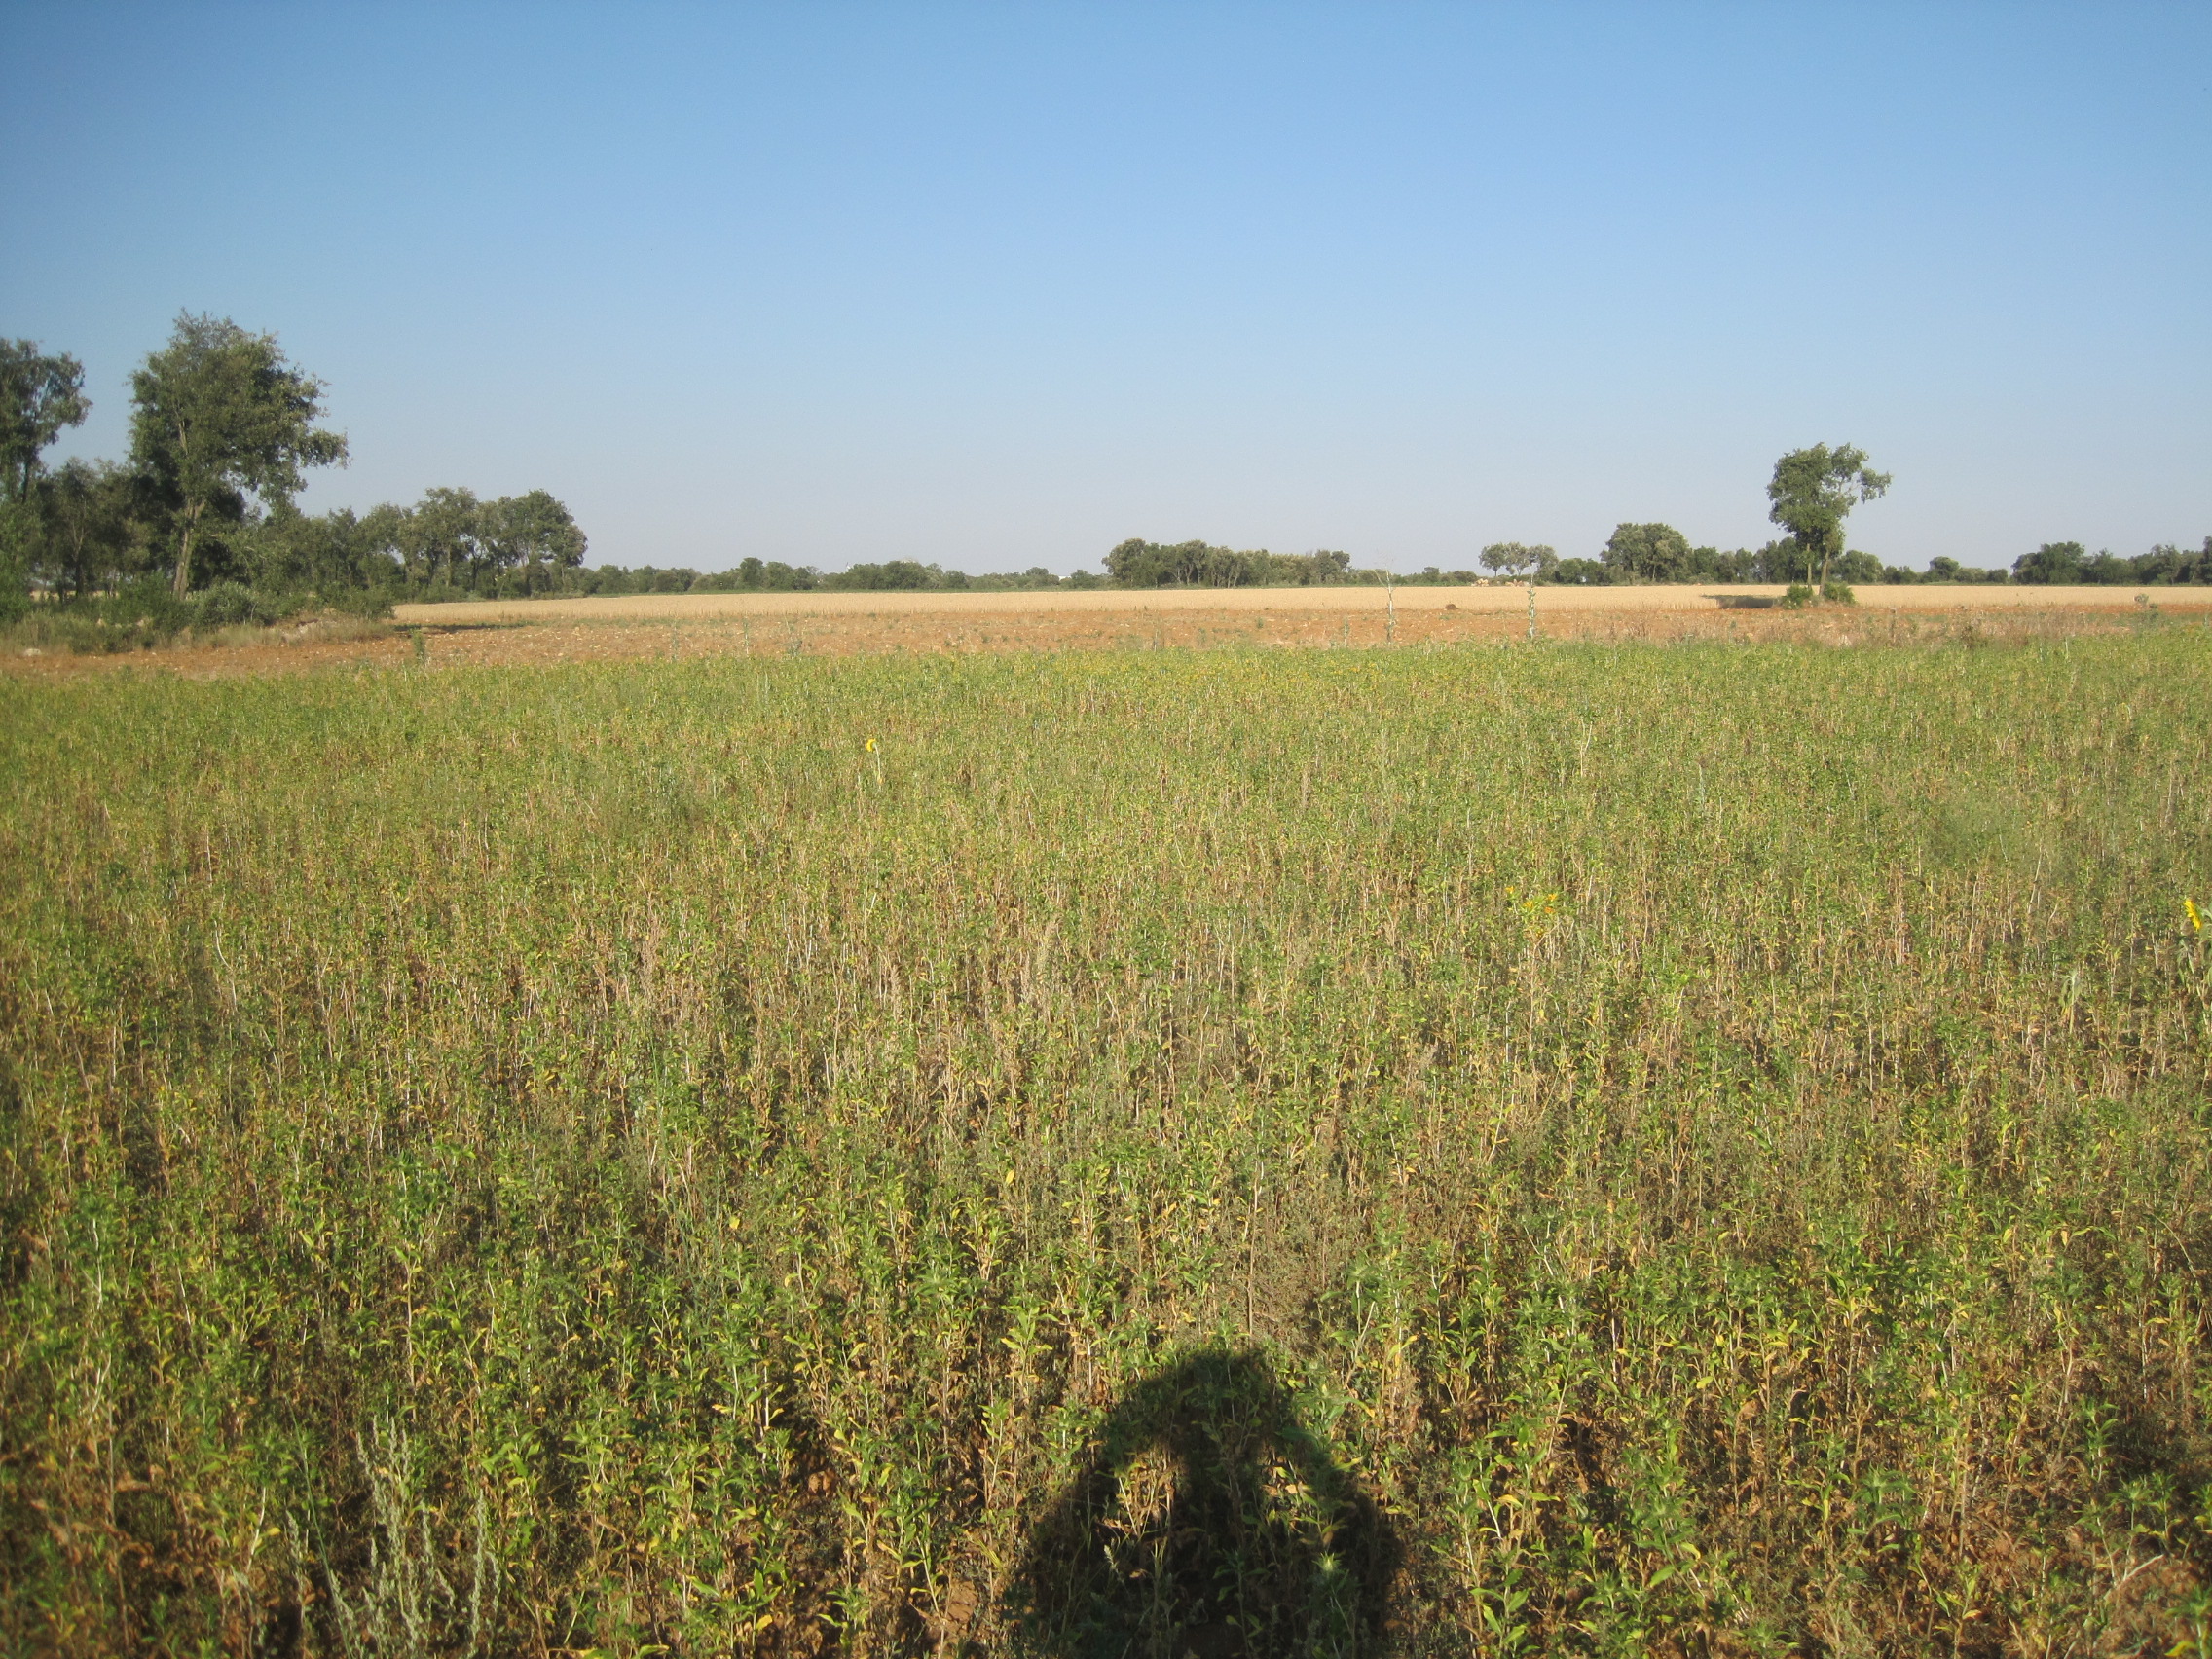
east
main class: Cropland
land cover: Other non-permanent industrial crops
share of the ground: > 75 %
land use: Agriculture (excluding fallow land and kitchen gardens)
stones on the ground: 10 - 25 %
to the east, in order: Other non-permanent industrial crops; Grass margins; Other bare soil; Grass margins; Common wheat; Grass margins; Sunflower
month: July
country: ES
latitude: 41.8242
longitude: -4.7481
